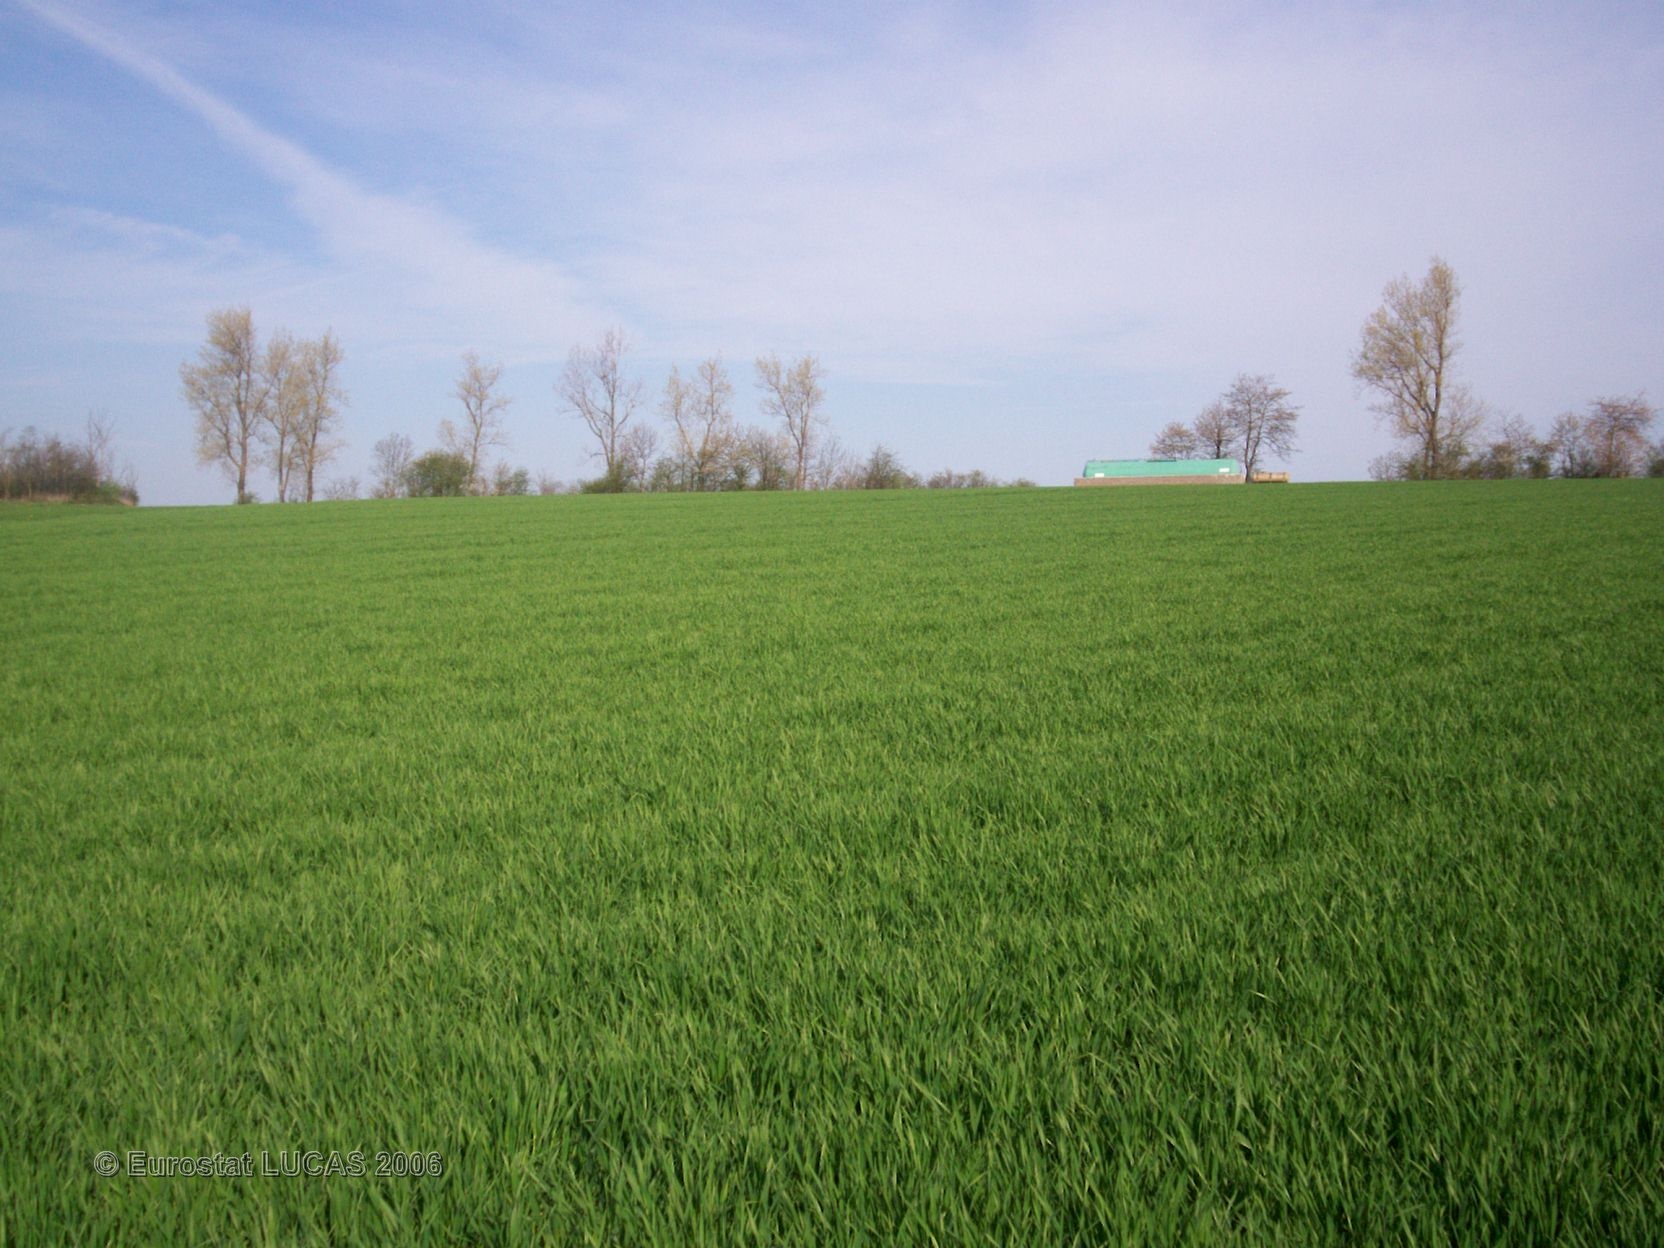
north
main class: Cropland
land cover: Barley
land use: Agriculture (excluding fallow land and kitchen gardens)
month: April
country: FR
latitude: 48.9057
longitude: 5.9476
